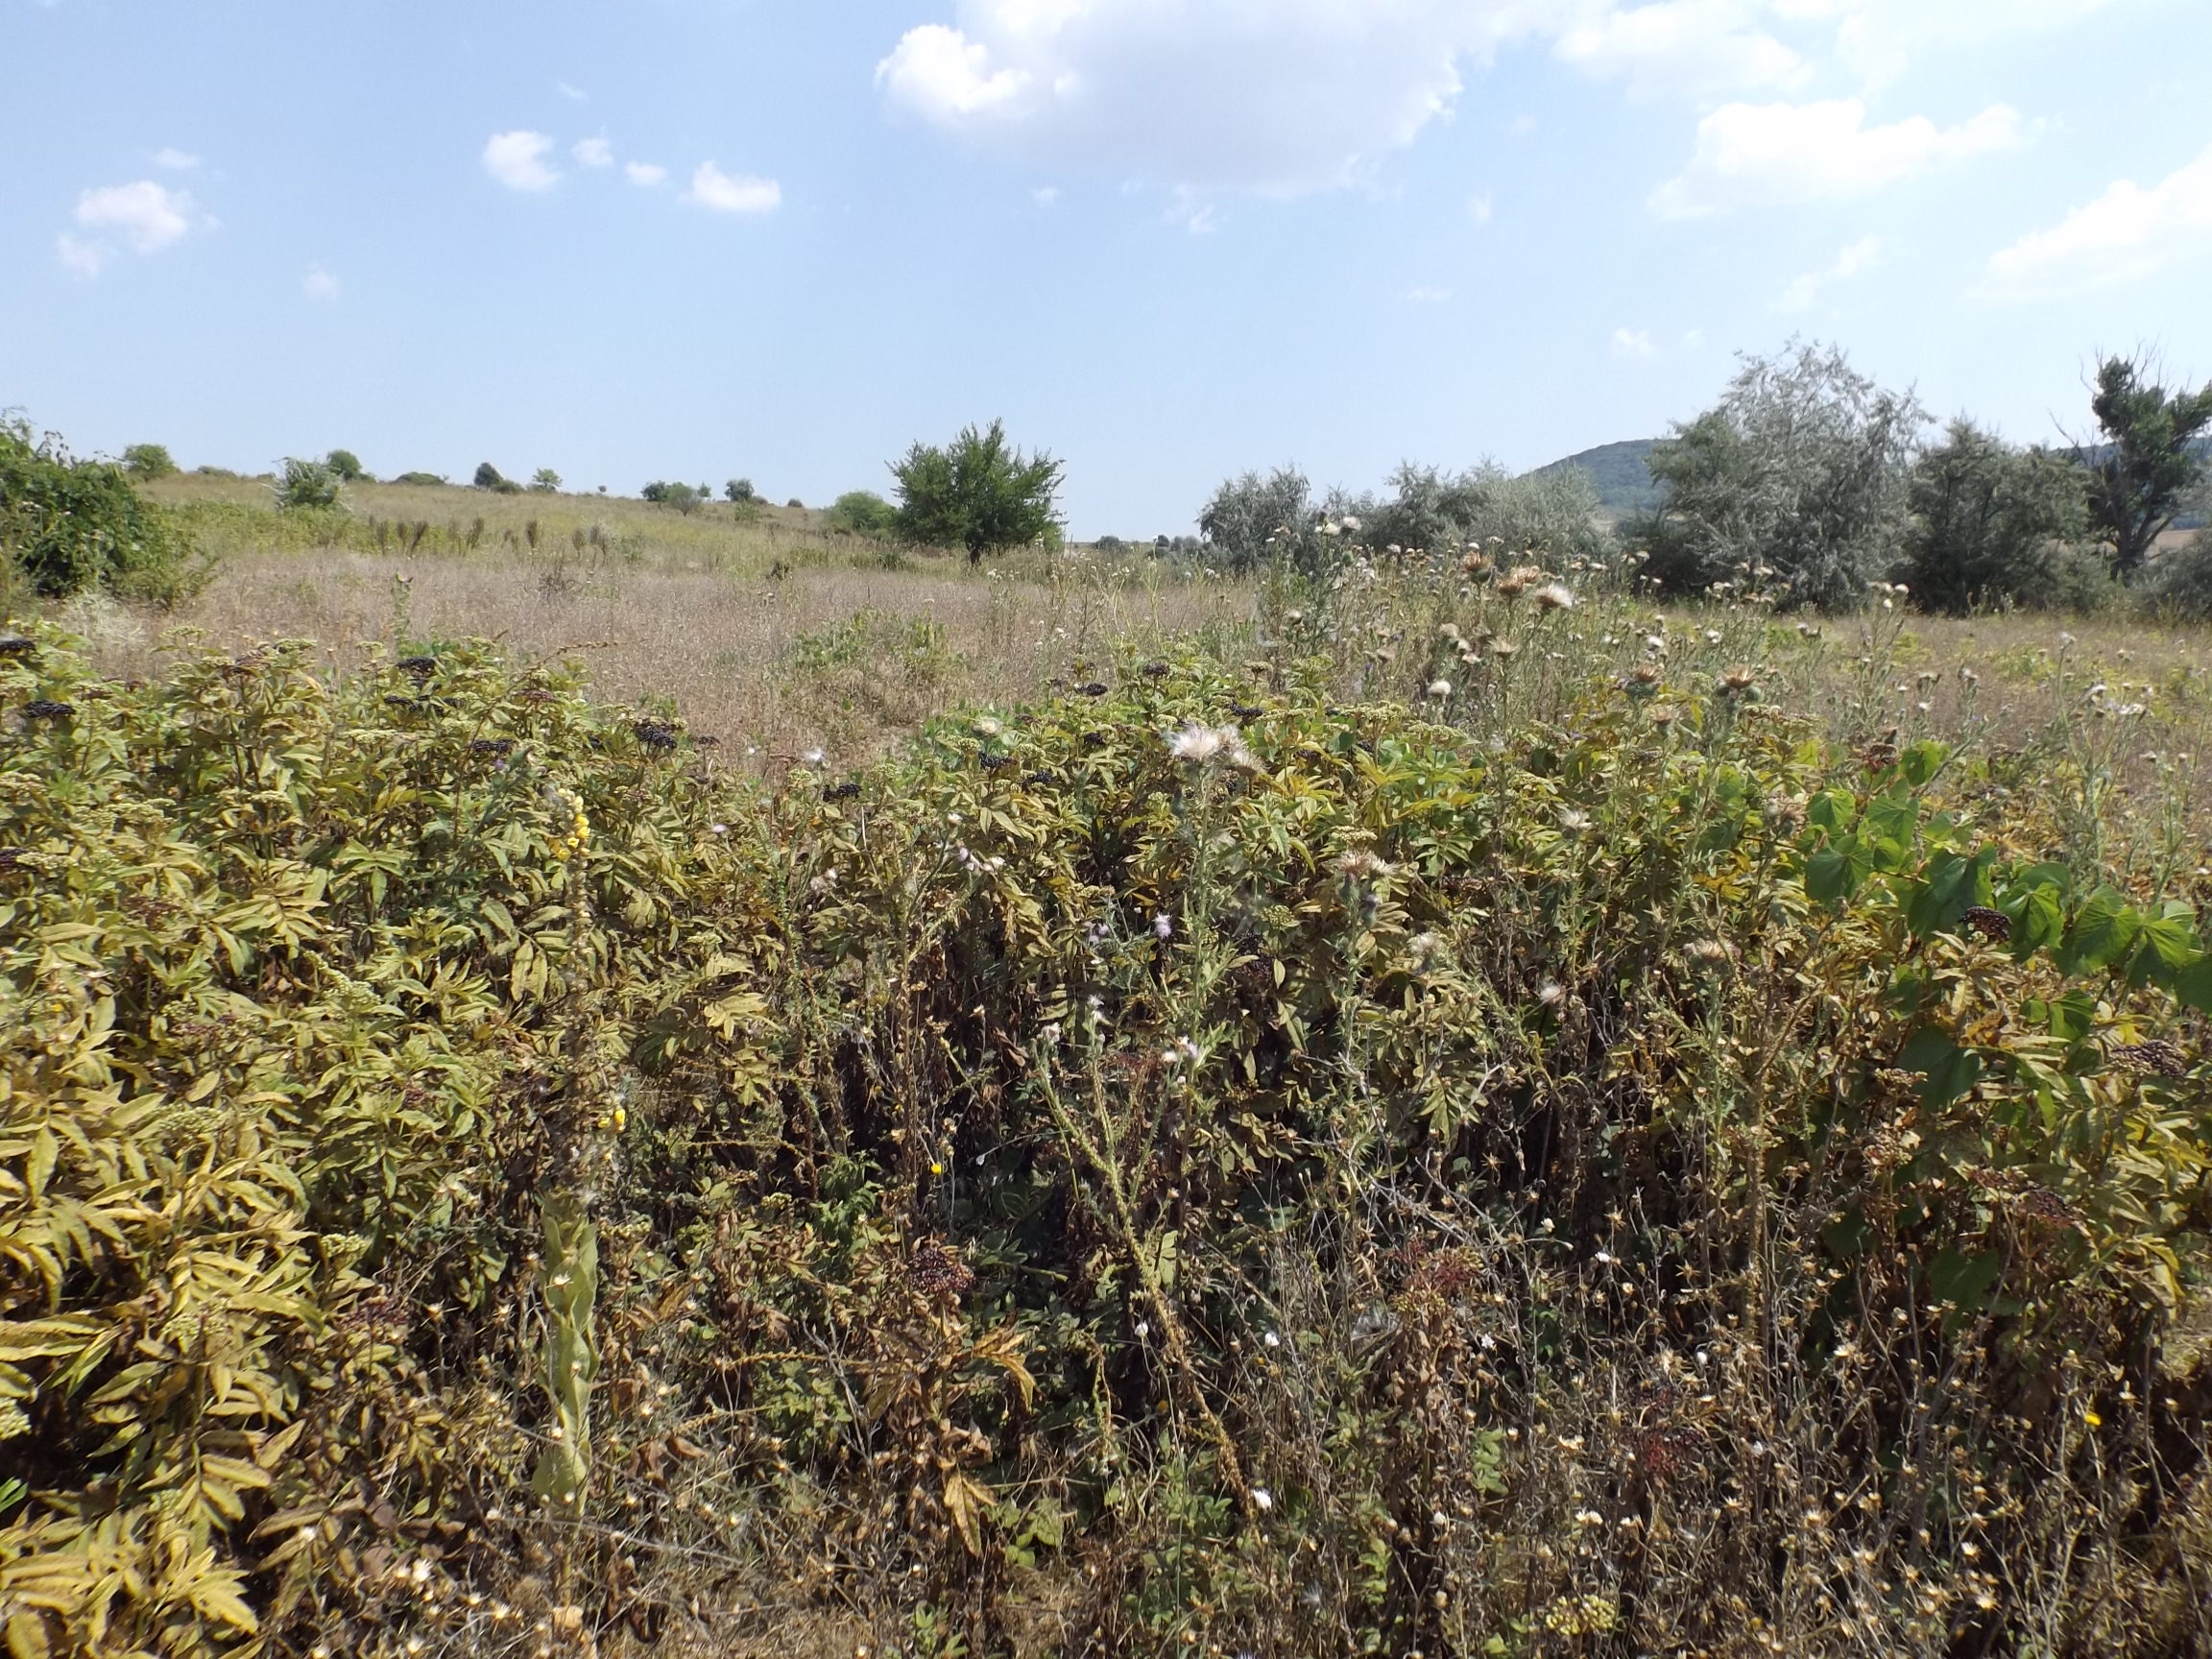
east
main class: Grassland
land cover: Spontaneously vegetated surfaces
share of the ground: > 75 %
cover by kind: herbaceous plants 95 %, shrubs 5 %
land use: Semi-natural and natural areas not in use
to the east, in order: Spontaneously vegetated surfaces; Tracks; Spontaneously vegetated surfaces; Broadleaved woodland
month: August
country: BG
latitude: 43.2398
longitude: 27.4786
